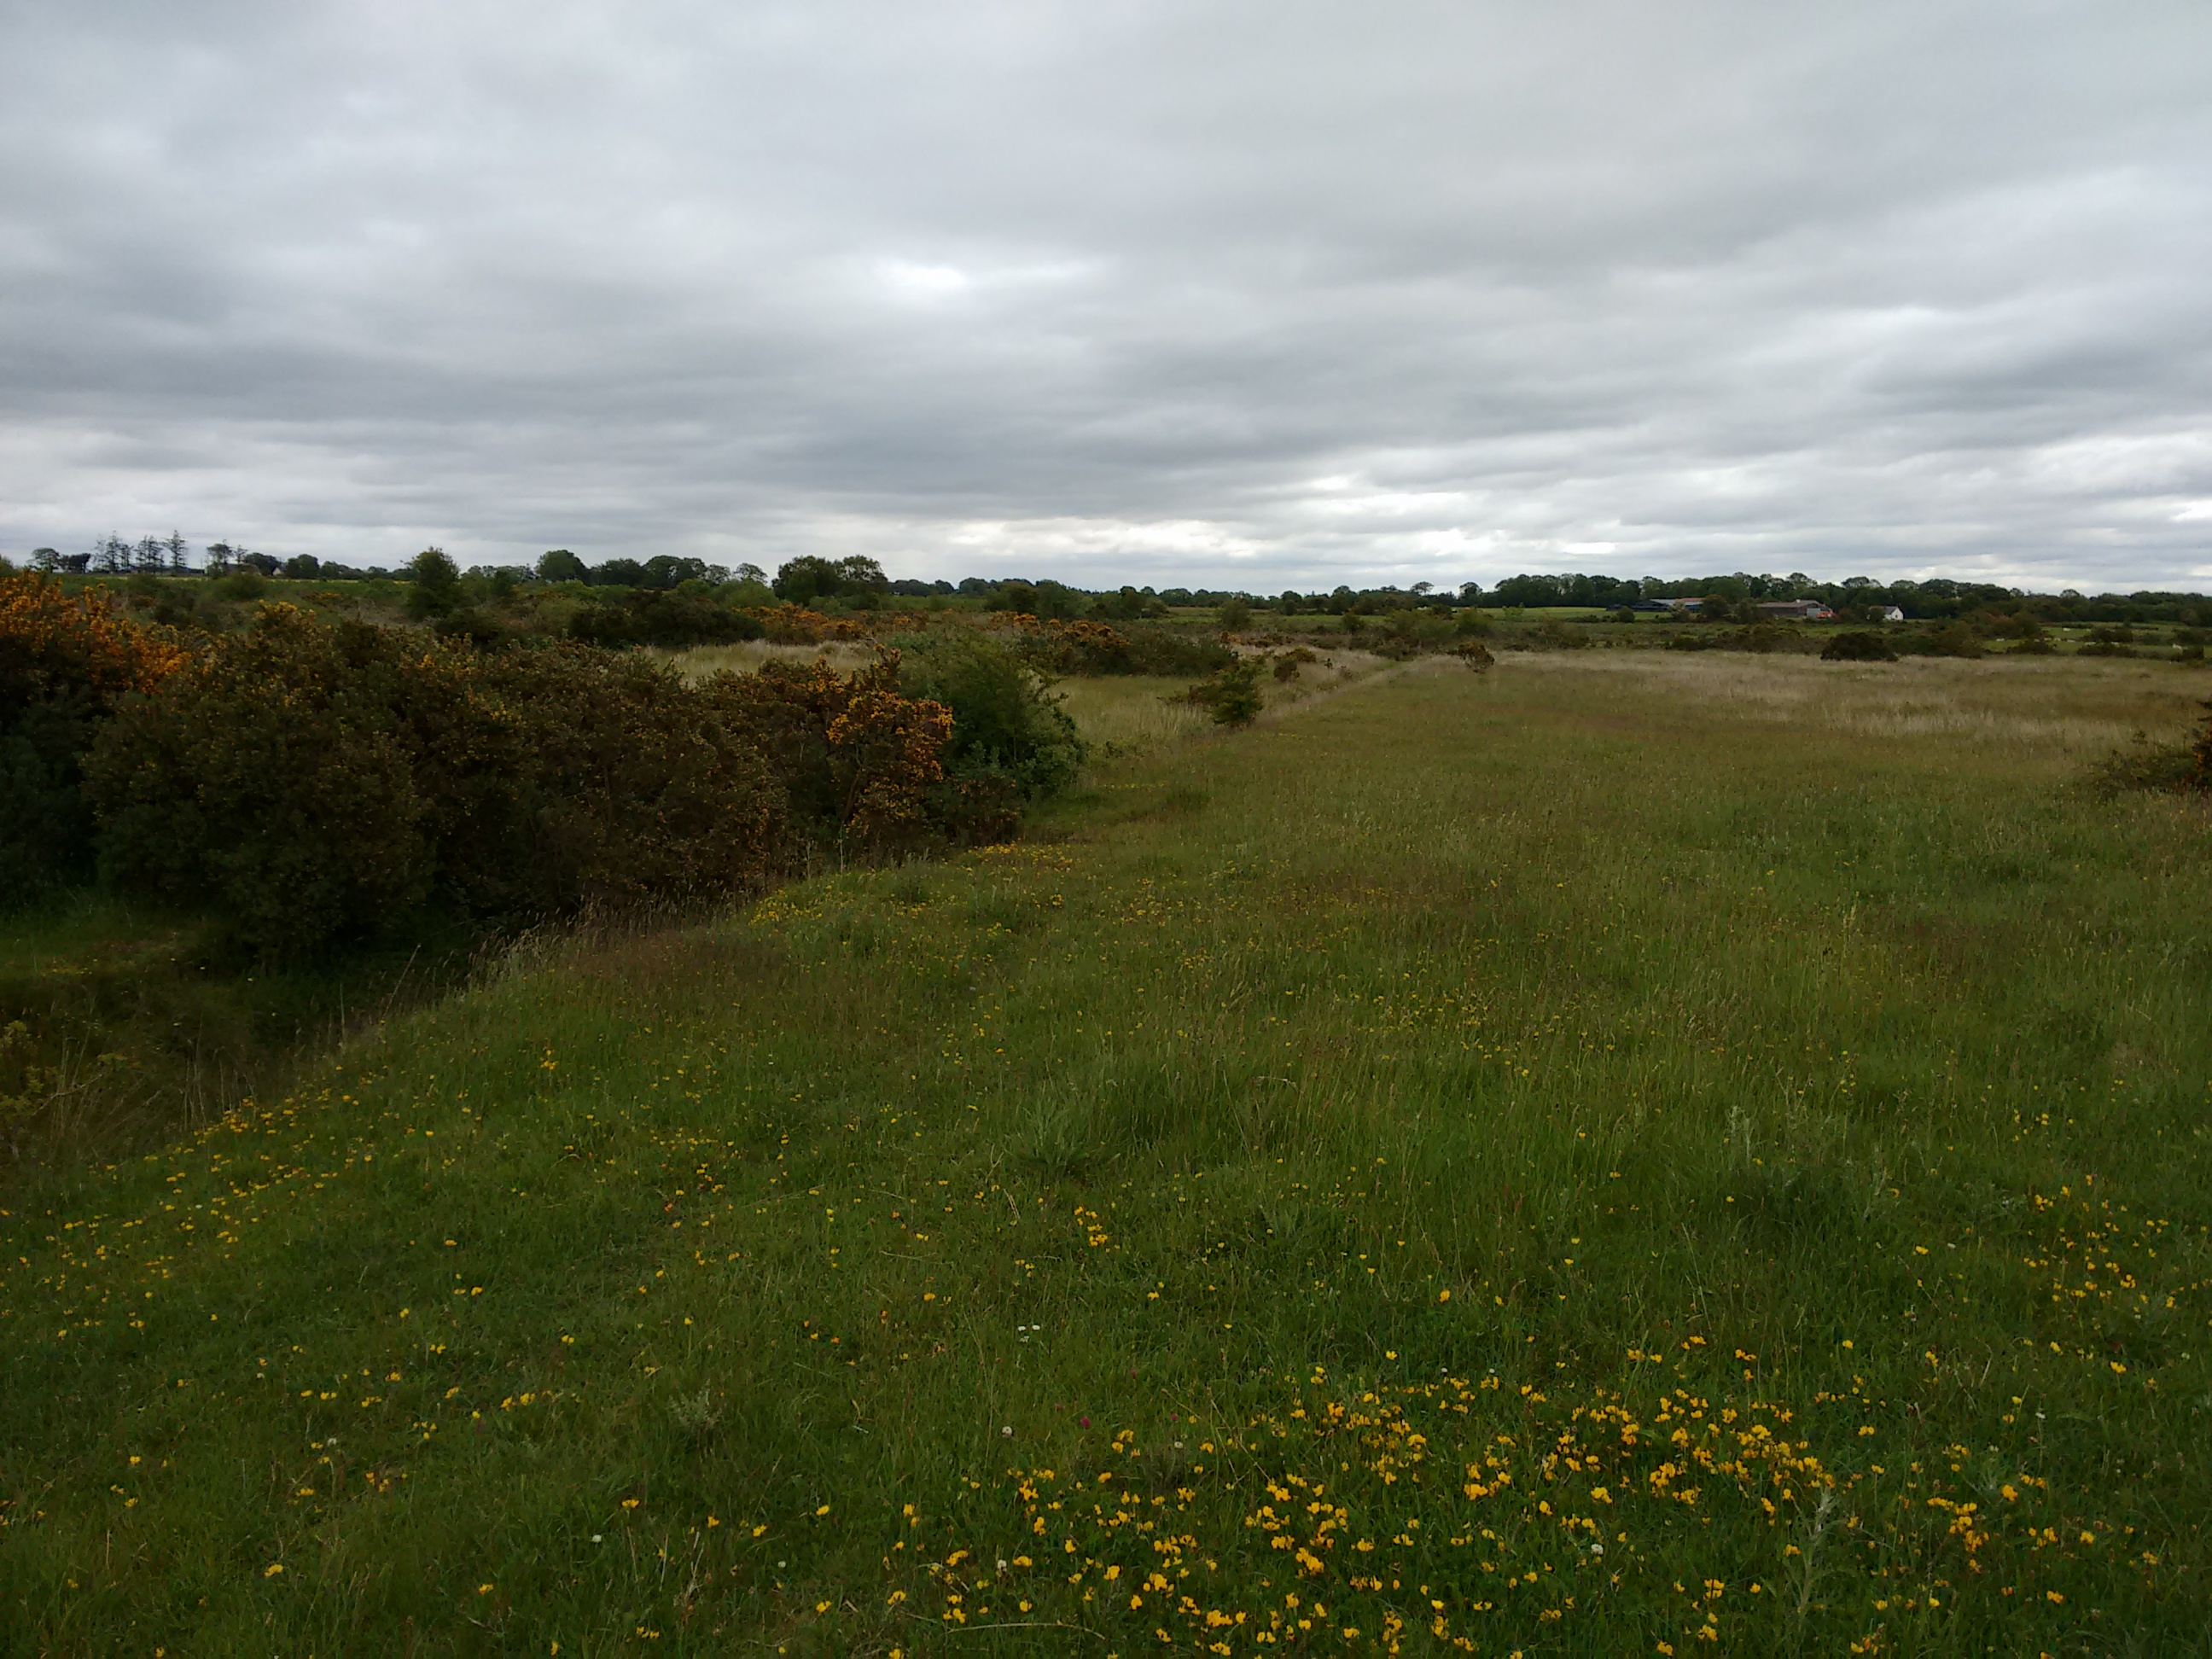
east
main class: Shrubland
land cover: Shrubland without tree cover
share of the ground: > 75 %
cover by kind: herbaceous plants 60 %, shrubs 40 %
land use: Agriculture (excluding fallow land and kitchen gardens)
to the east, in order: Shrubland without tree cover; Ditches and canals; Shrubland without tree cover; Shrubland with sparse tree cover; Ditches and canals; Artificial constructions; Ditches and canals; Grass margins; Fences; Grassland without tree/shrub cover; Fences; Dry stone walls; Broadleaved woodland; Grassland without tree/shrub cover; Broadleaved woodland
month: June
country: IE
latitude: 53.5703
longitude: -8.8243
